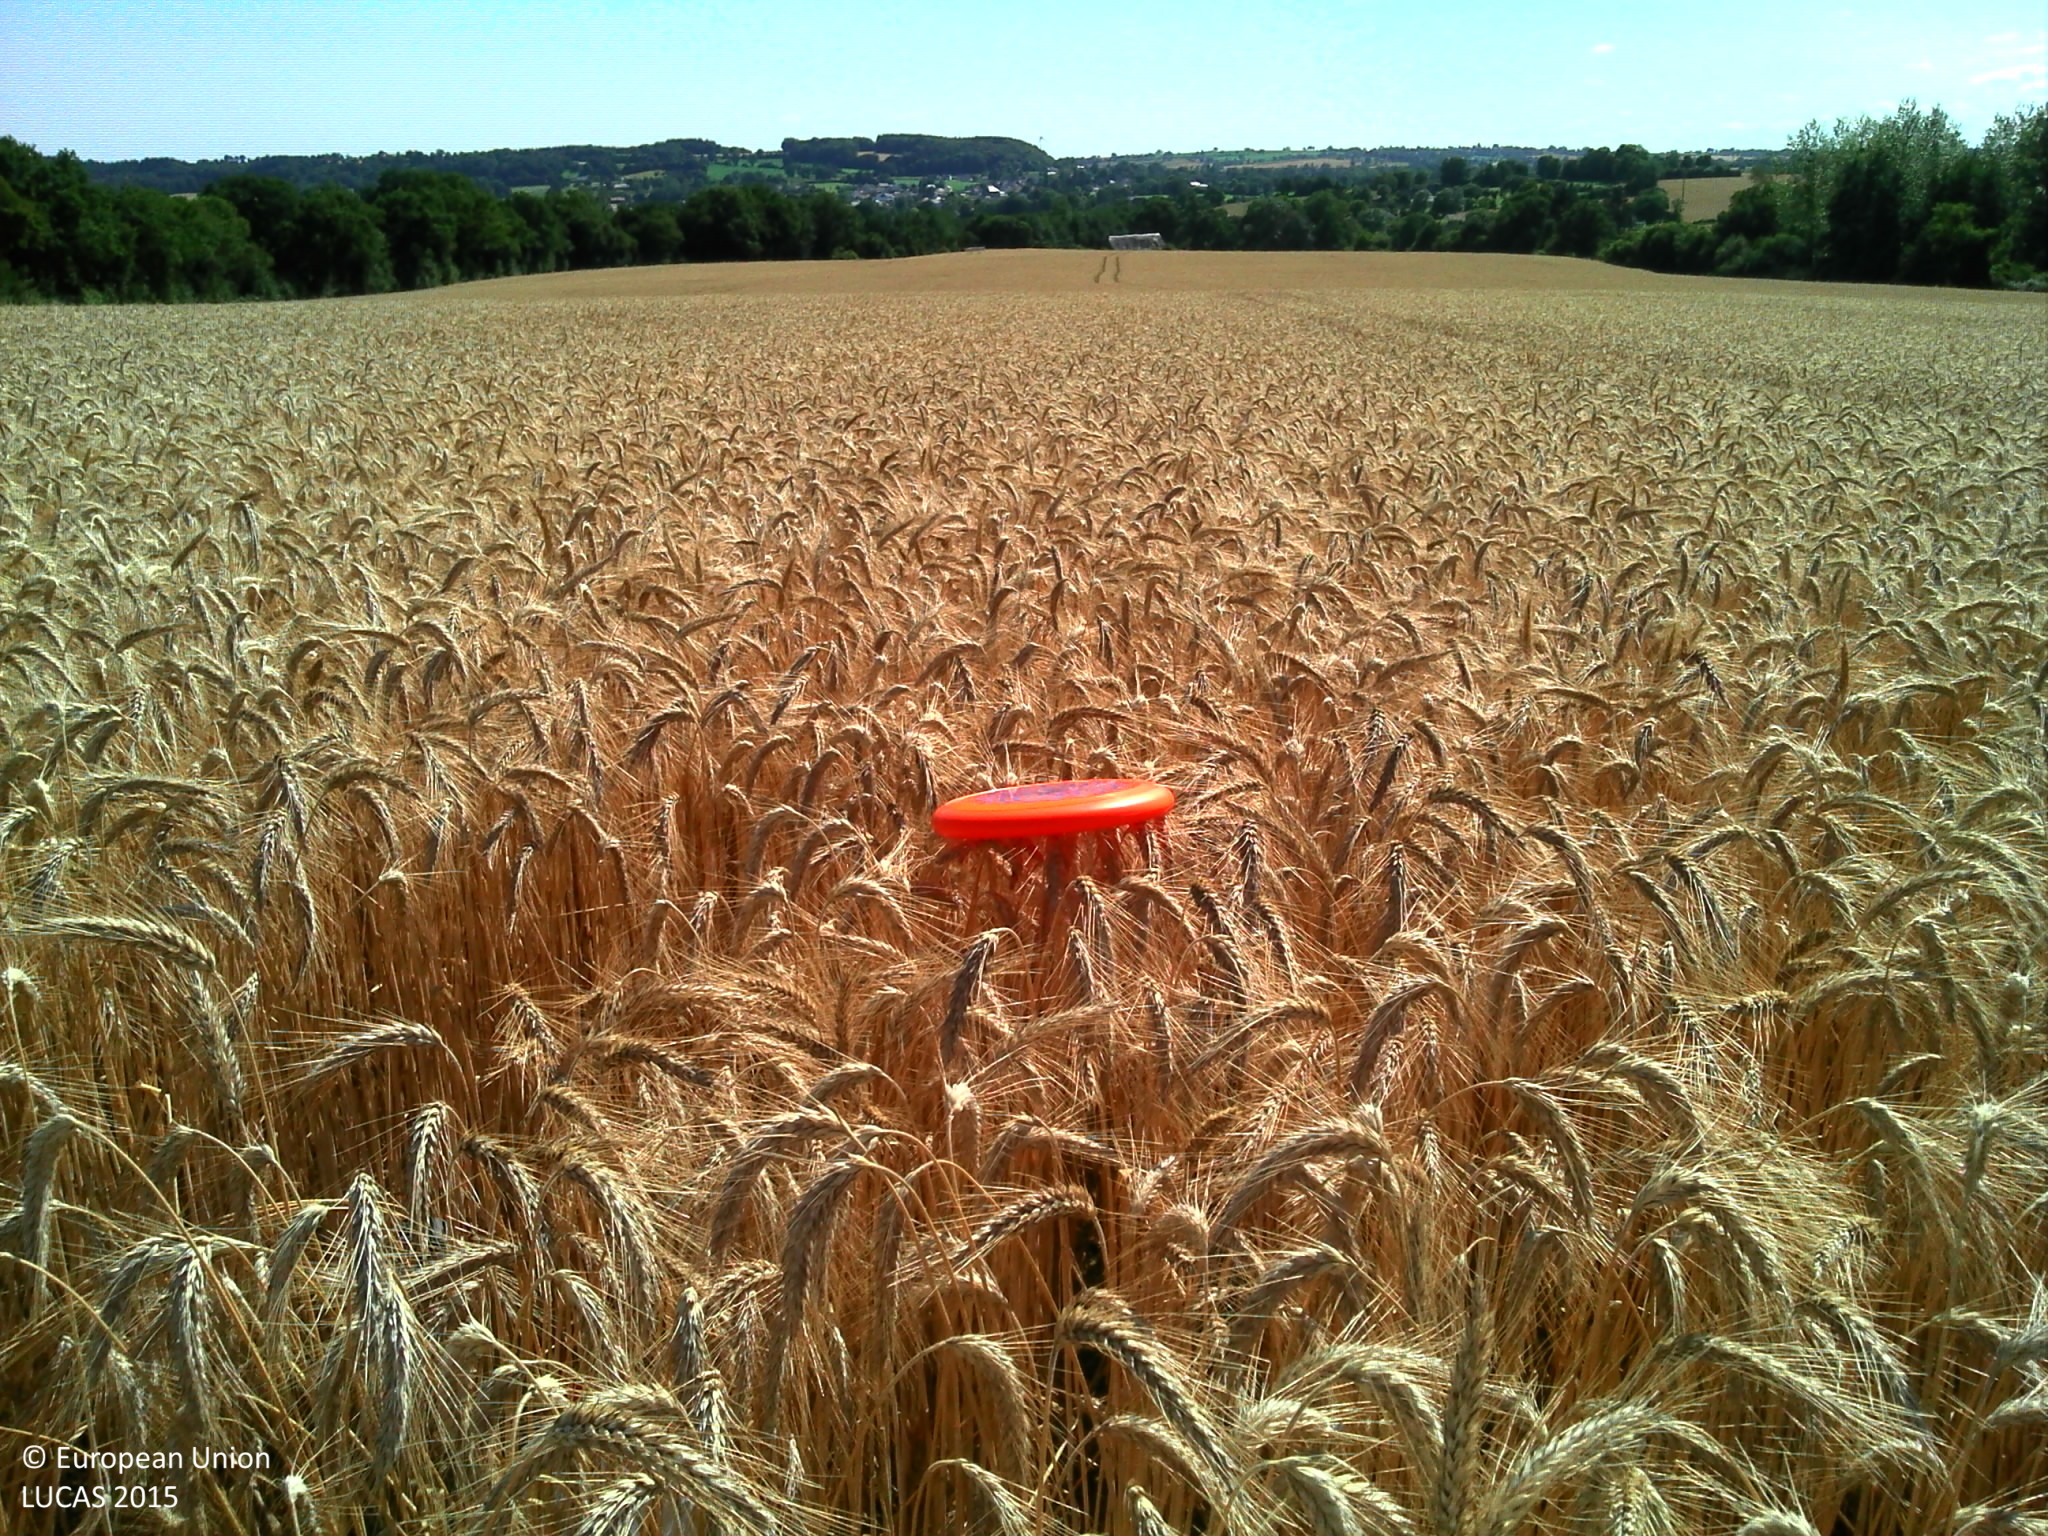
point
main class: Cropland
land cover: Common wheat
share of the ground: > 75 %
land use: Agriculture (excluding fallow land and kitchen gardens)
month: July
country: FR
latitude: 48.4755
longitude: -0.1903
